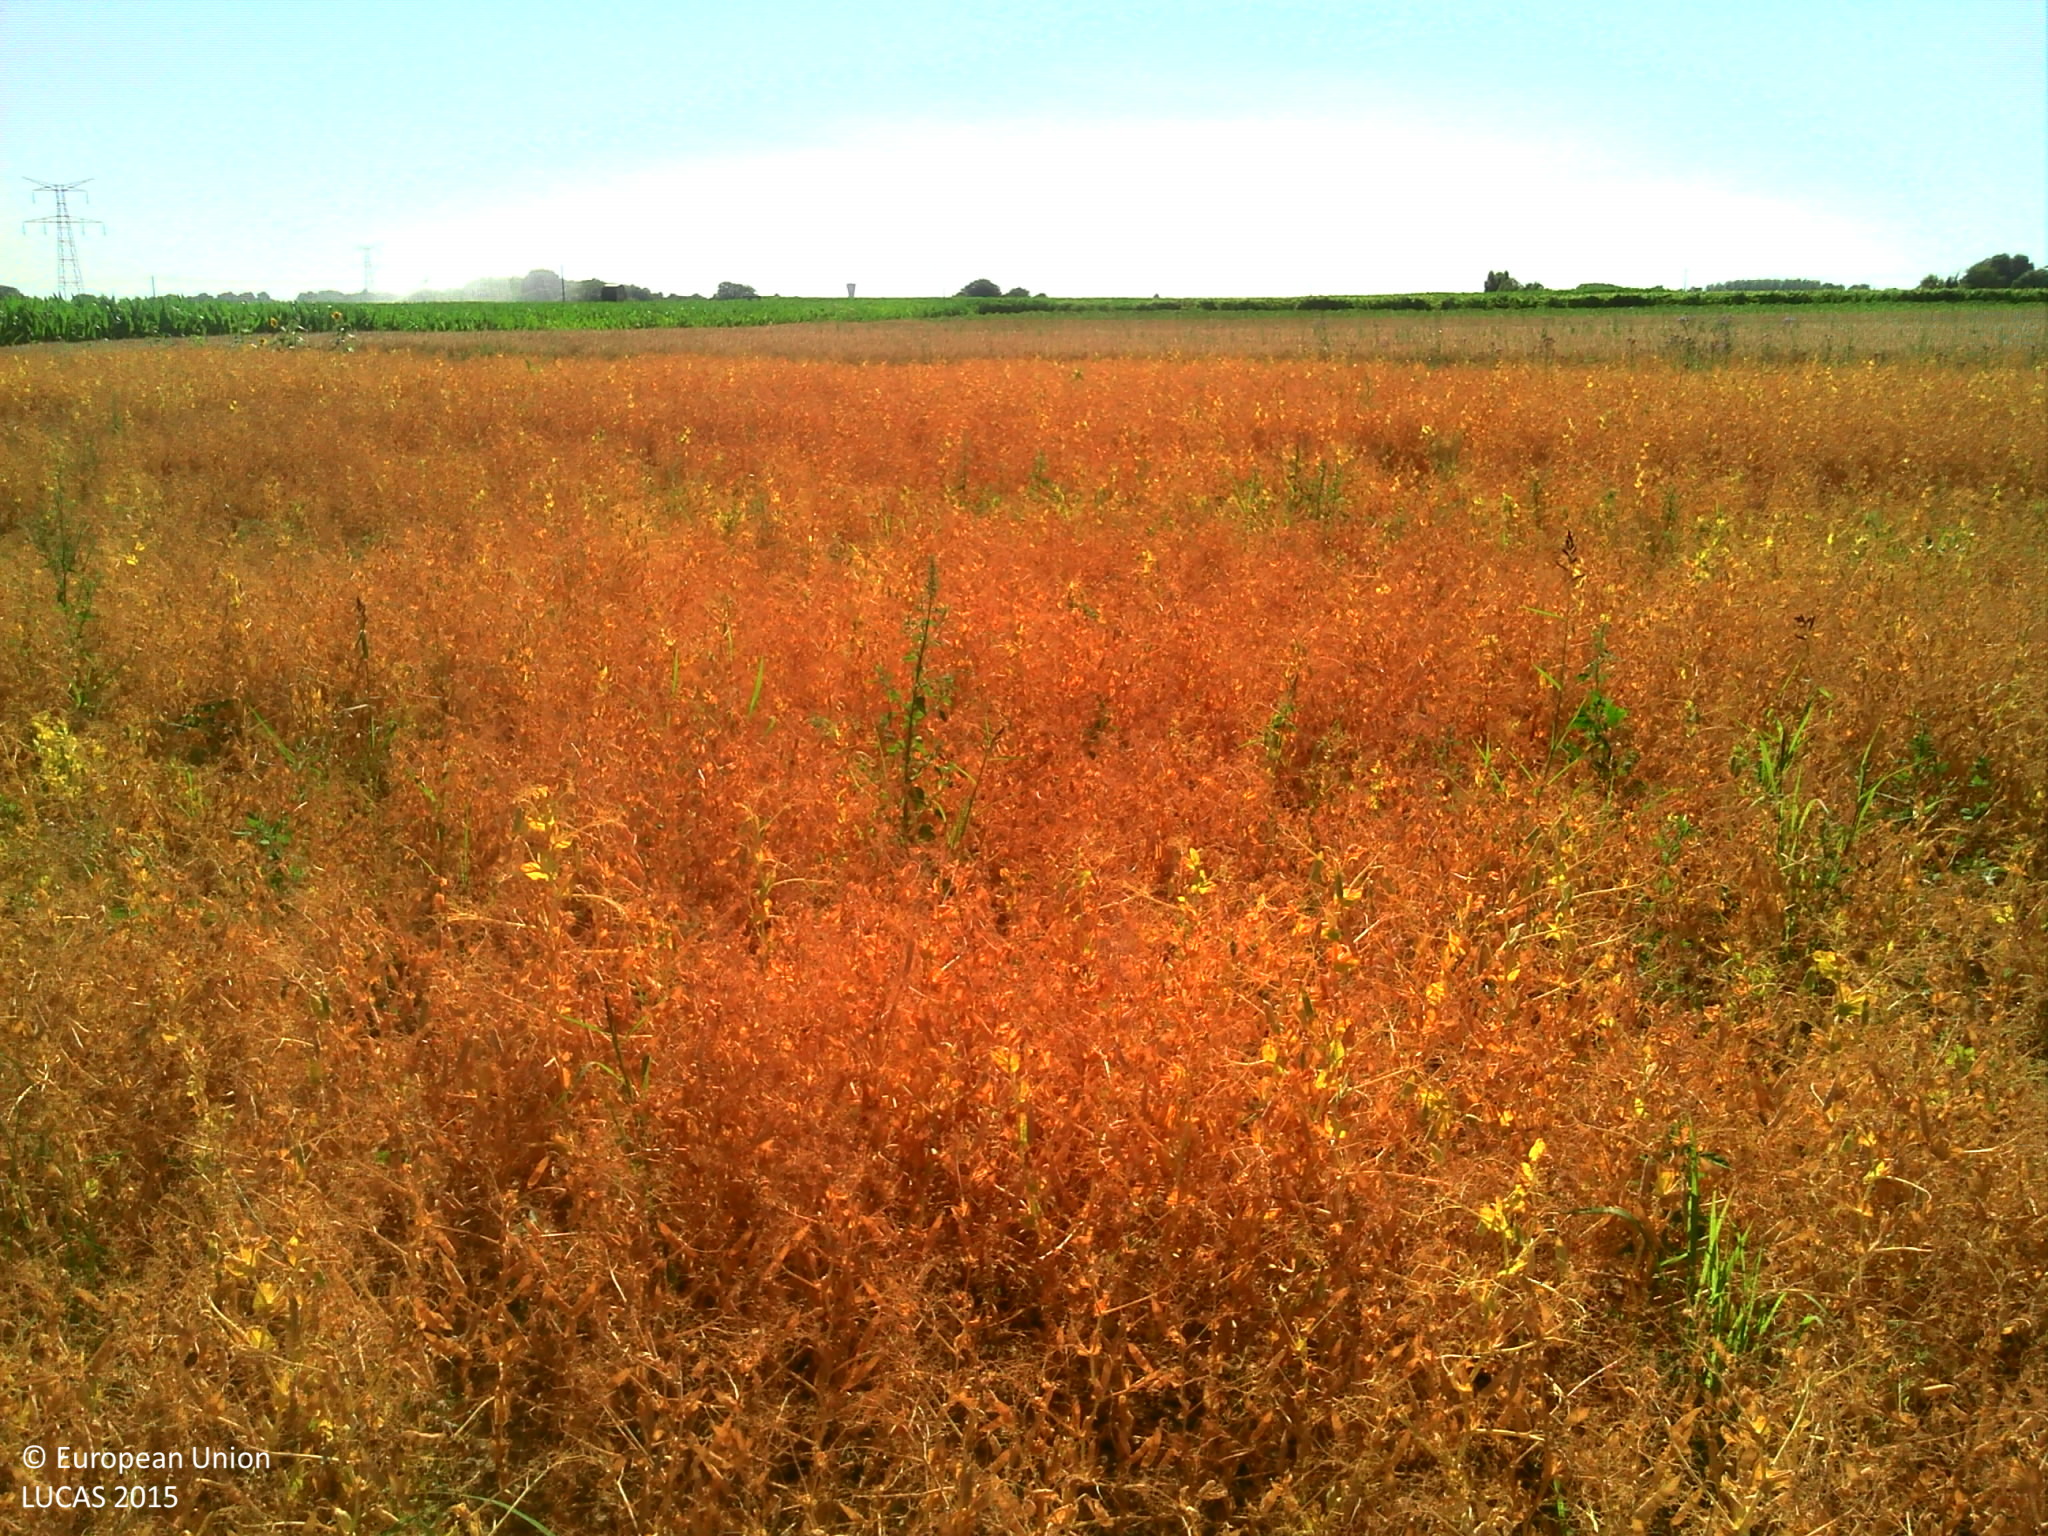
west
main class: Cropland
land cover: Dry pulses
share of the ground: > 75 %
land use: Agriculture (excluding fallow land and kitchen gardens)
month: June
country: FR
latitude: 45.6303
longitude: -0.7094
